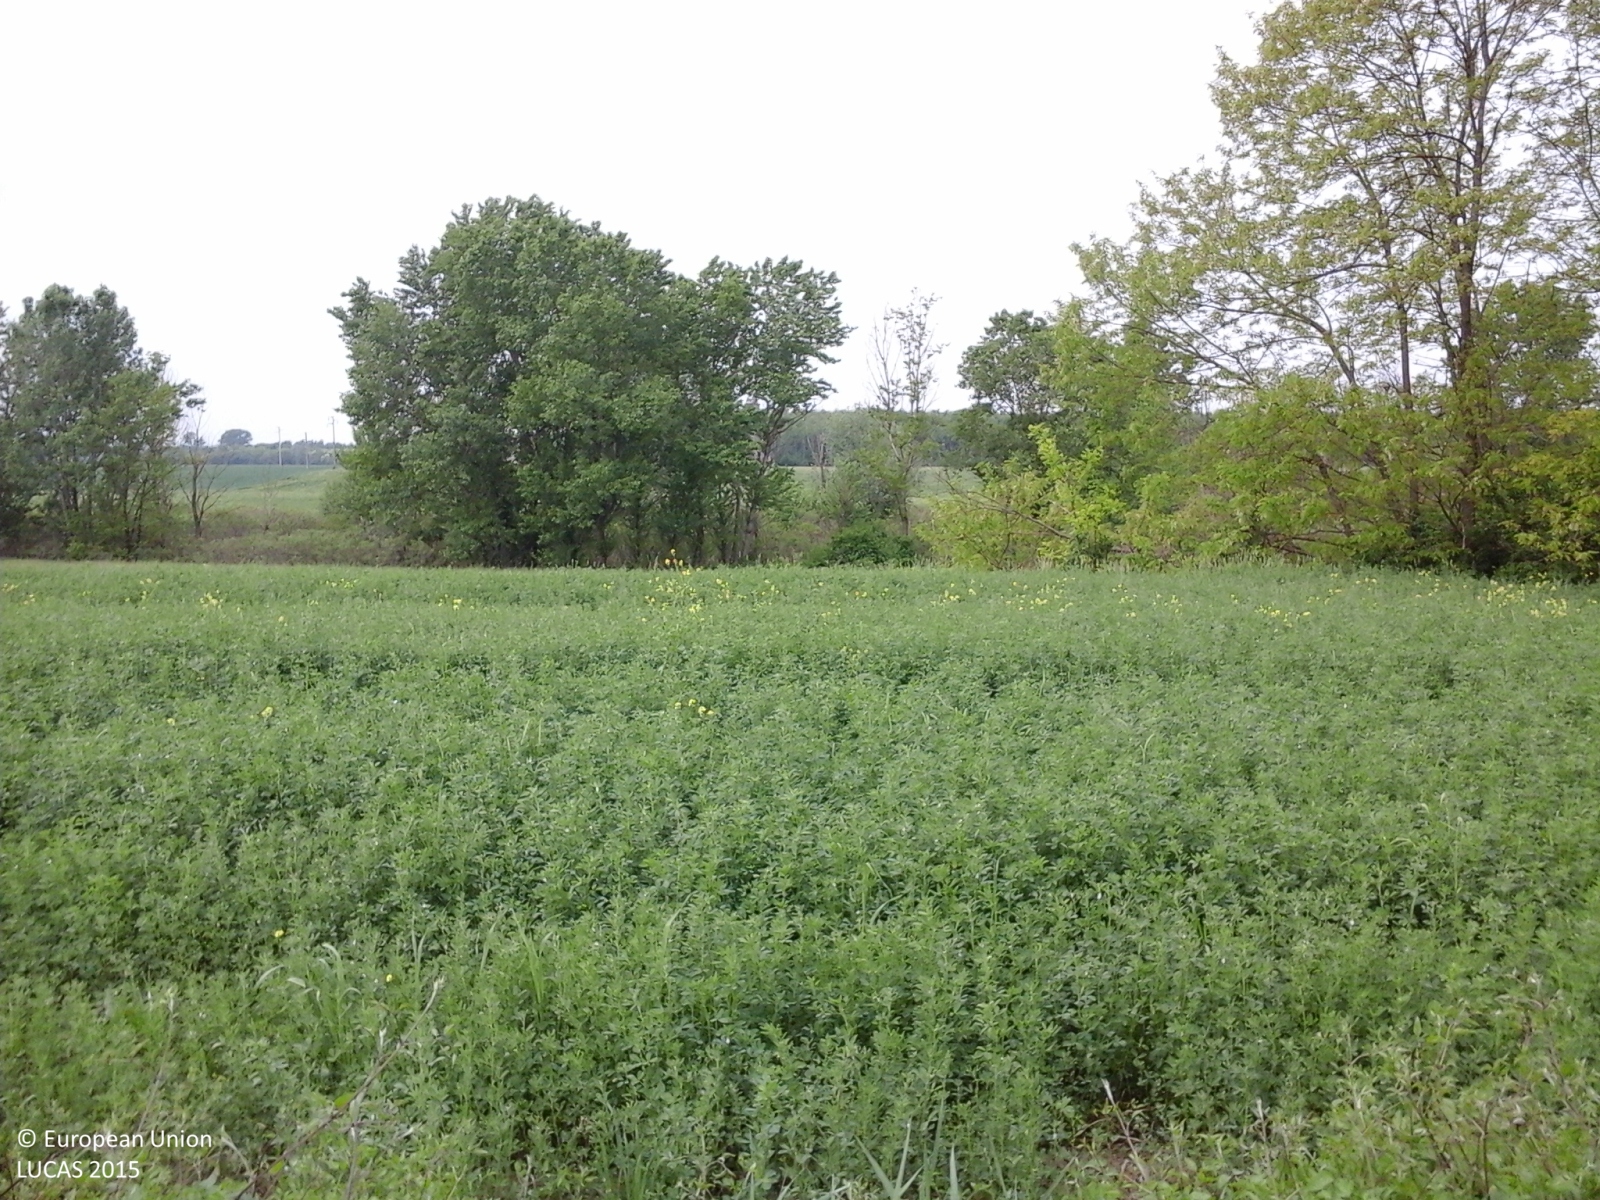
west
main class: Cropland
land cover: Maize
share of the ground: < 10 %
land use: Agriculture (excluding fallow land and kitchen gardens)
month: April
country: IT
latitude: 45.0708
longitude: 9.5310
